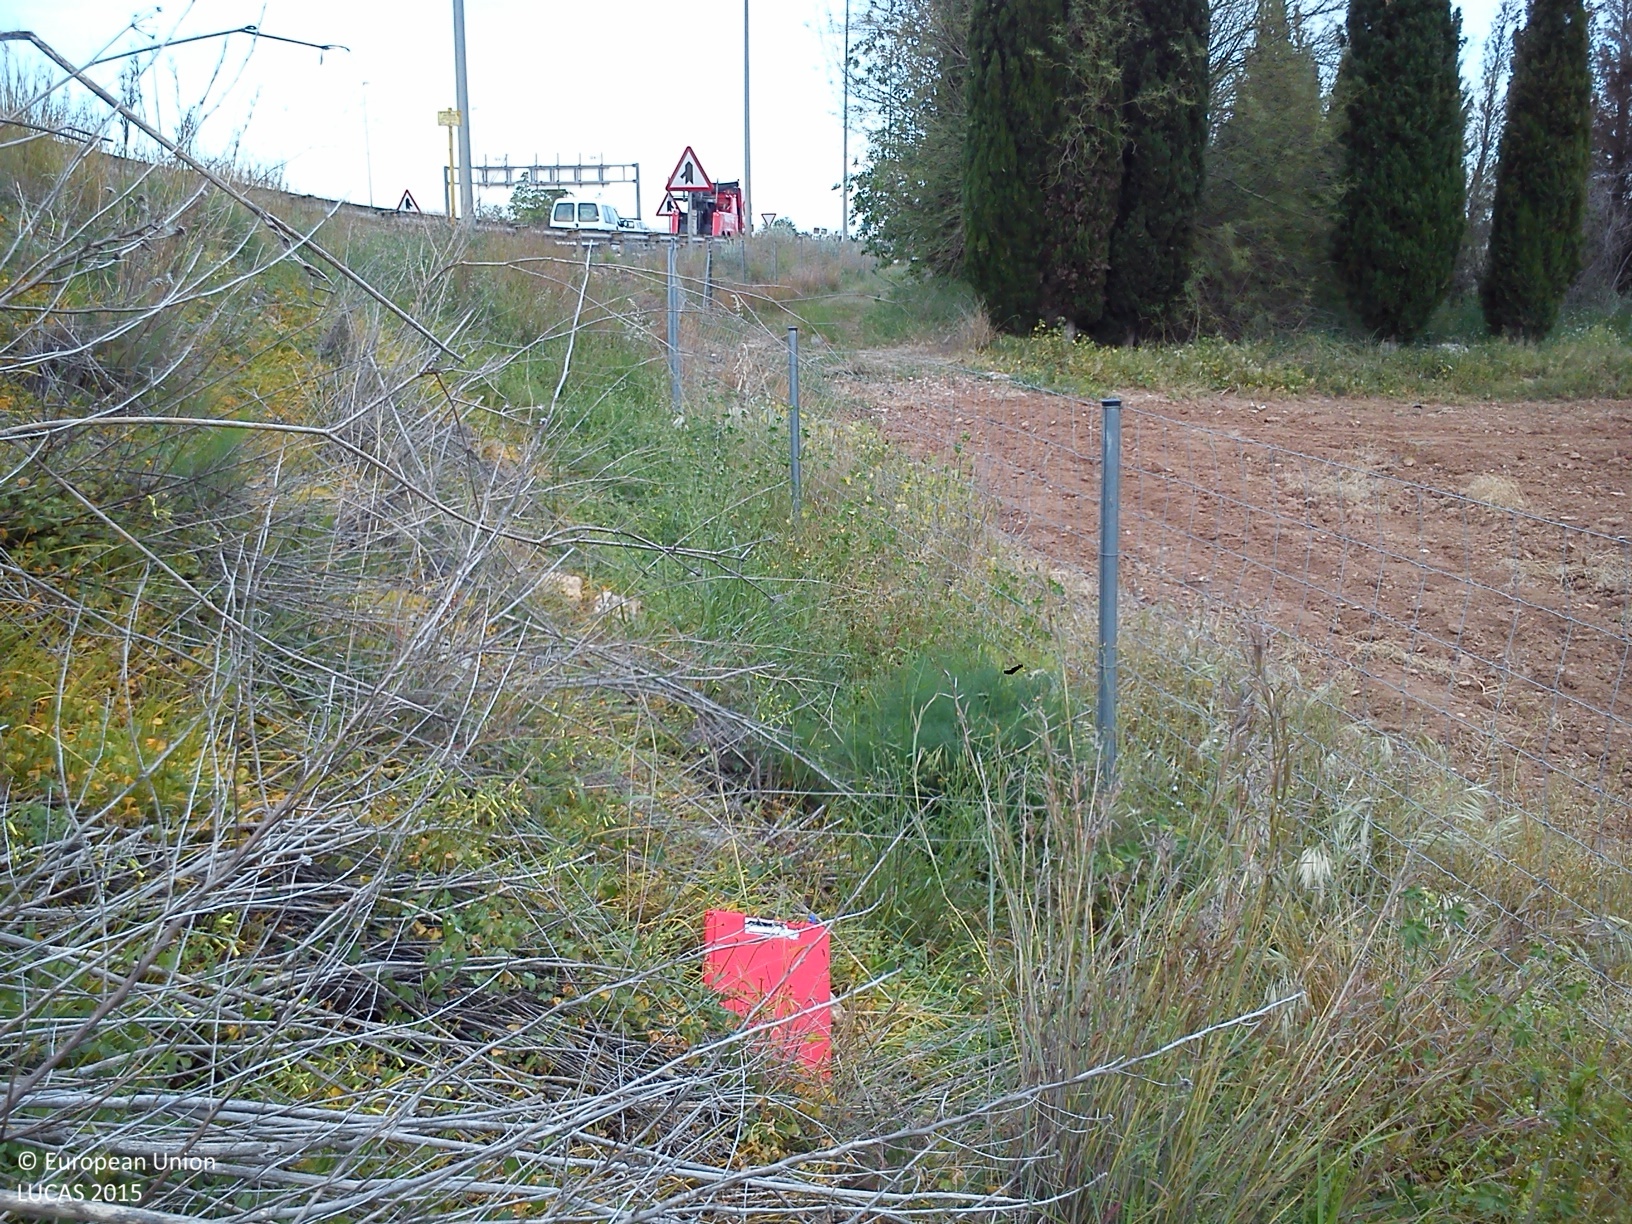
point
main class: Shrubland
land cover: Shrubland without tree cover
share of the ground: > 75 %
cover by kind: herbaceous plants 65 %, shrubs 35 %
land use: Abandoned areas
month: April
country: ES
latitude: 39.4738
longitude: -0.5883
